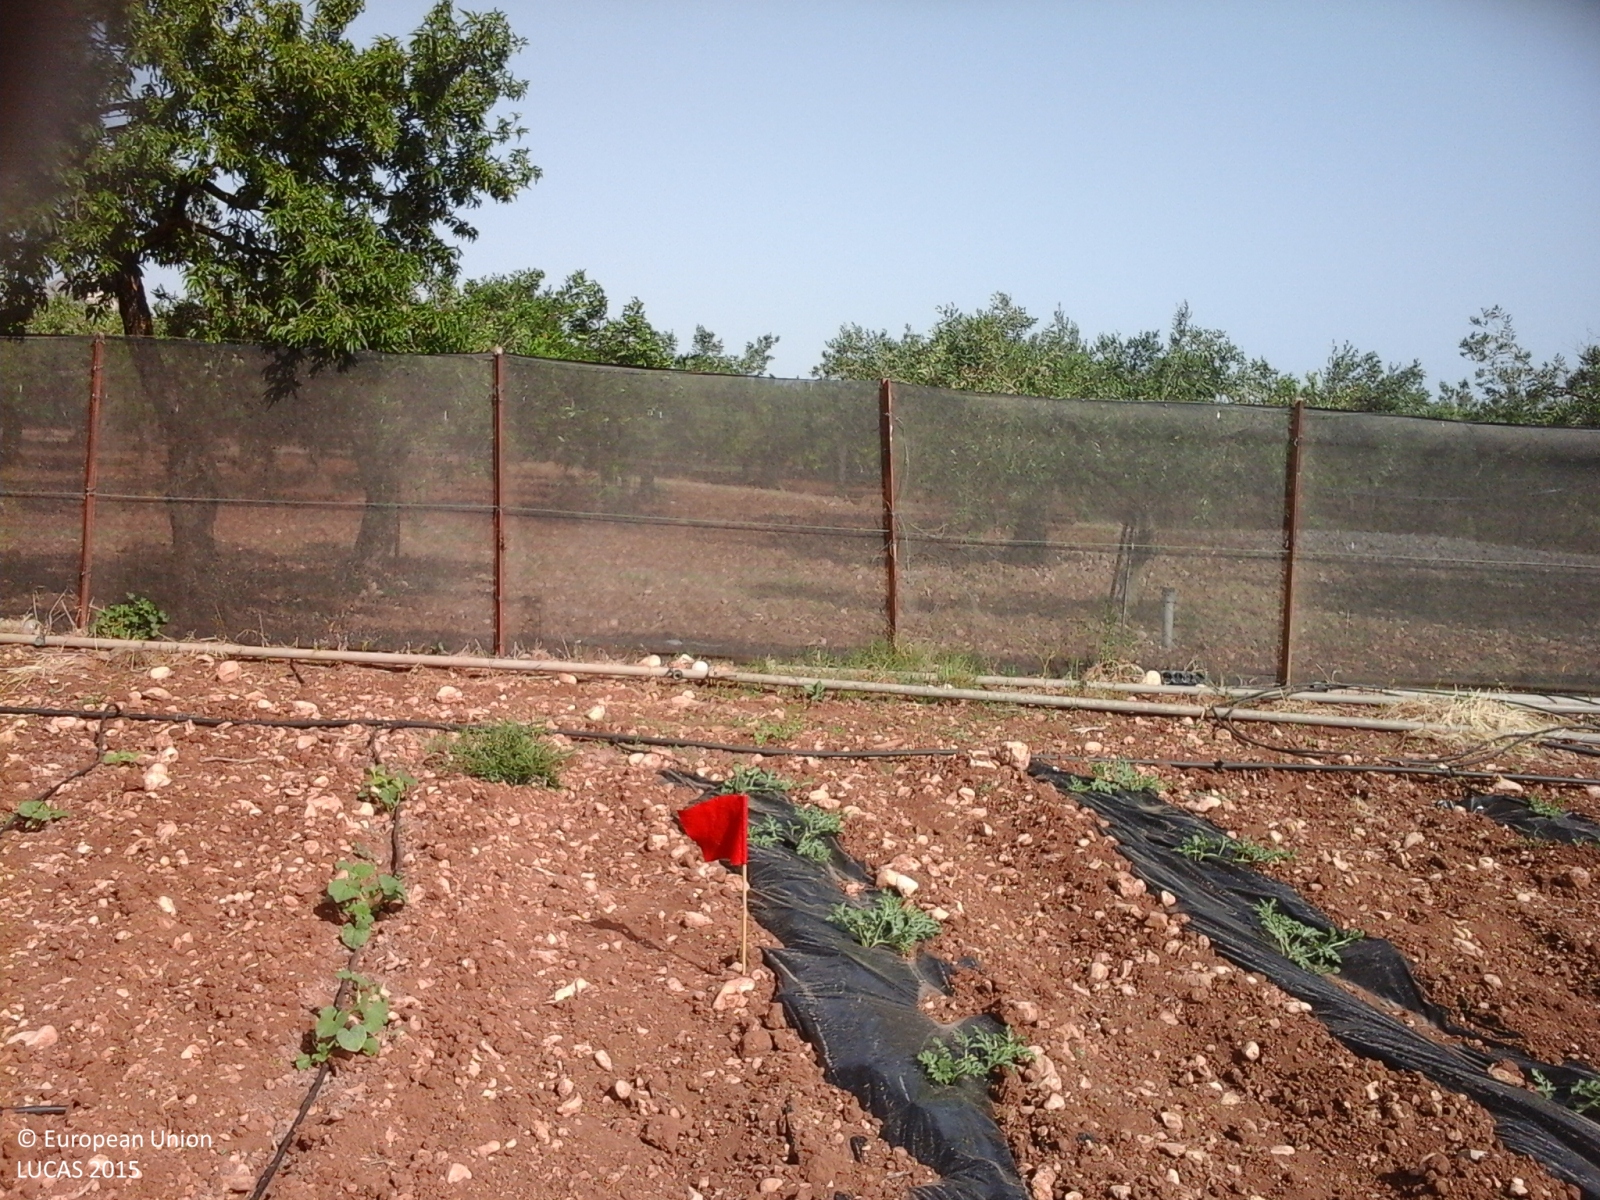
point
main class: Cropland
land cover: Other fresh vegetables
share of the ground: 10 - 25 %
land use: Agriculture (excluding fallow land and kitchen gardens)
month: May
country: IT
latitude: 37.5709
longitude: 13.0676
